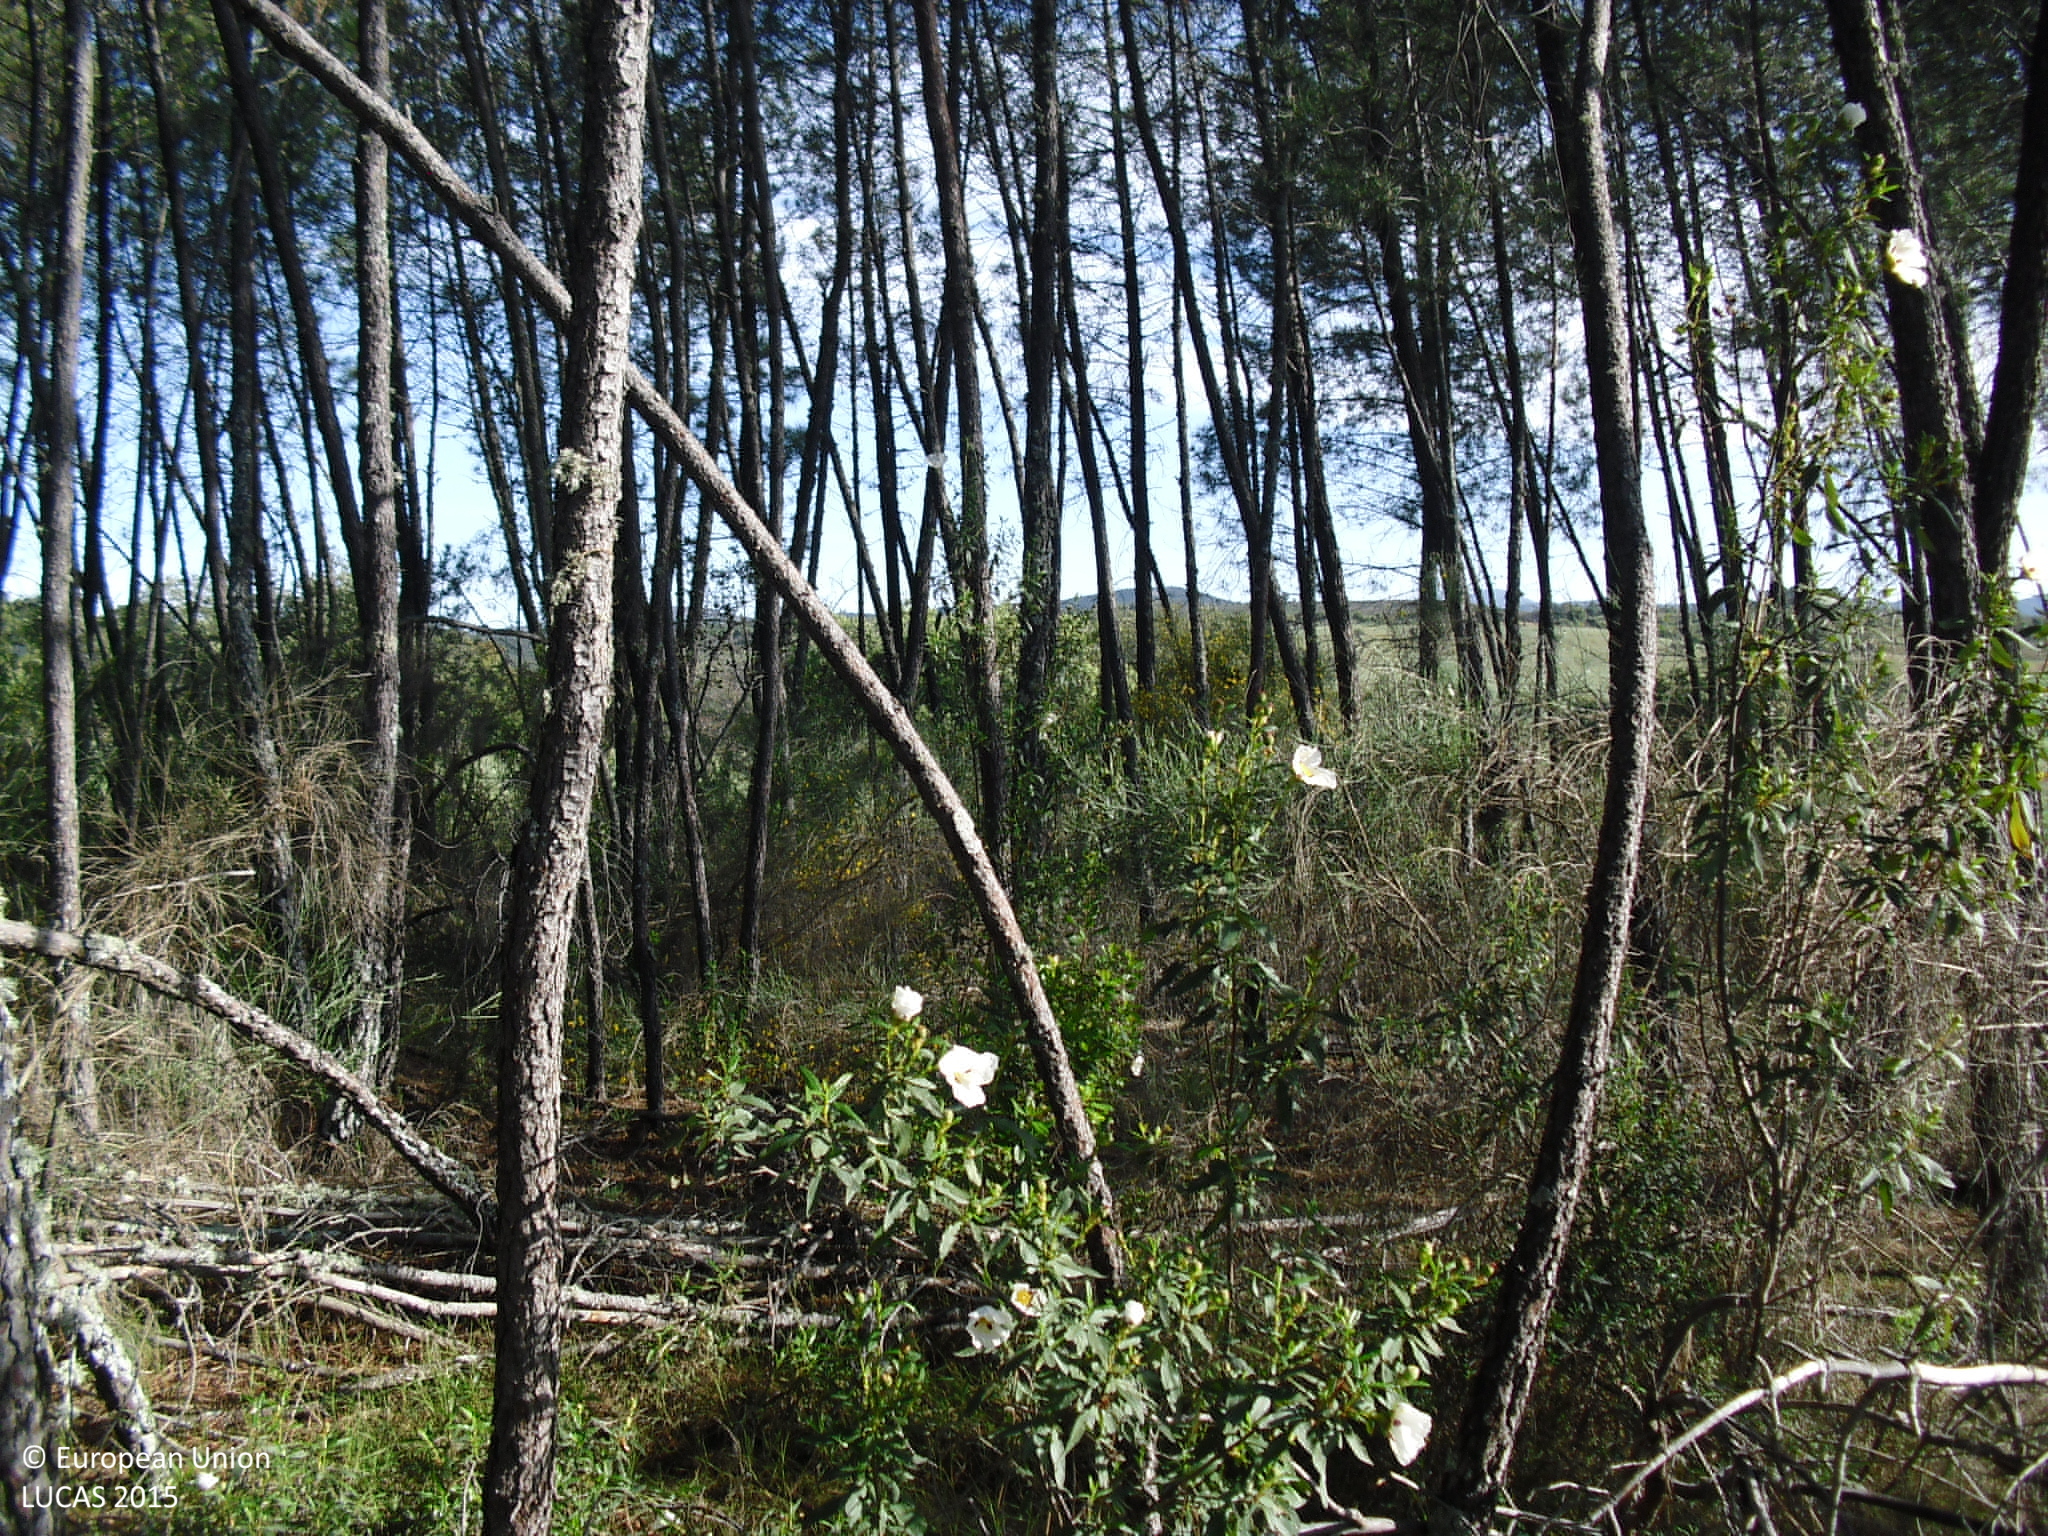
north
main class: Woodland
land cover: Pine dominated coniferous woodland
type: coniferous forest of the mediterranean region
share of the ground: > 75 %
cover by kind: coniferous forest trees 90 %, herbaceous plants 10 %
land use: Forestry
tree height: > 5 m
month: April
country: ES
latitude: 40.0574
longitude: -6.8161
